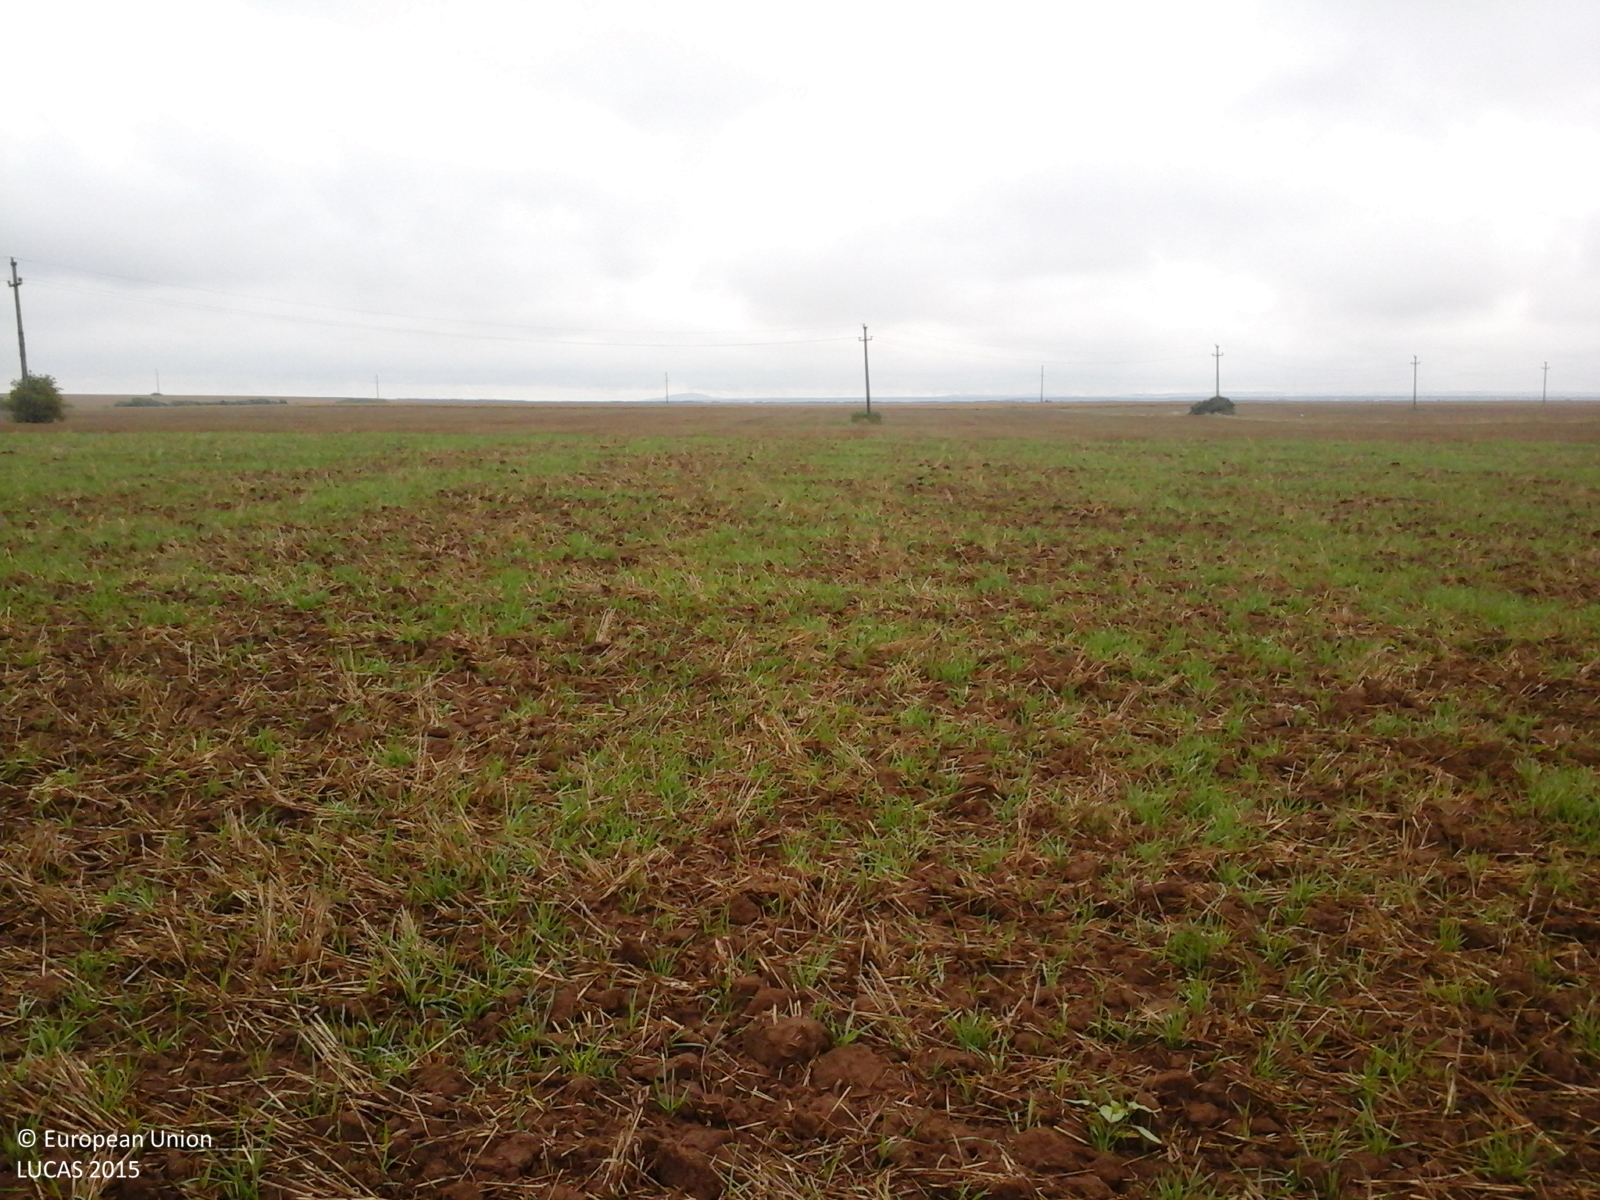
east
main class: Cropland
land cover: Common wheat
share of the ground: 25 - 50 %
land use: Agriculture (excluding fallow land and kitchen gardens)
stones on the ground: < 10 %
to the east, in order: Common wheat; Electric lines; Common wheat
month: September
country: RO
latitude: 46.9561
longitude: 21.7515
